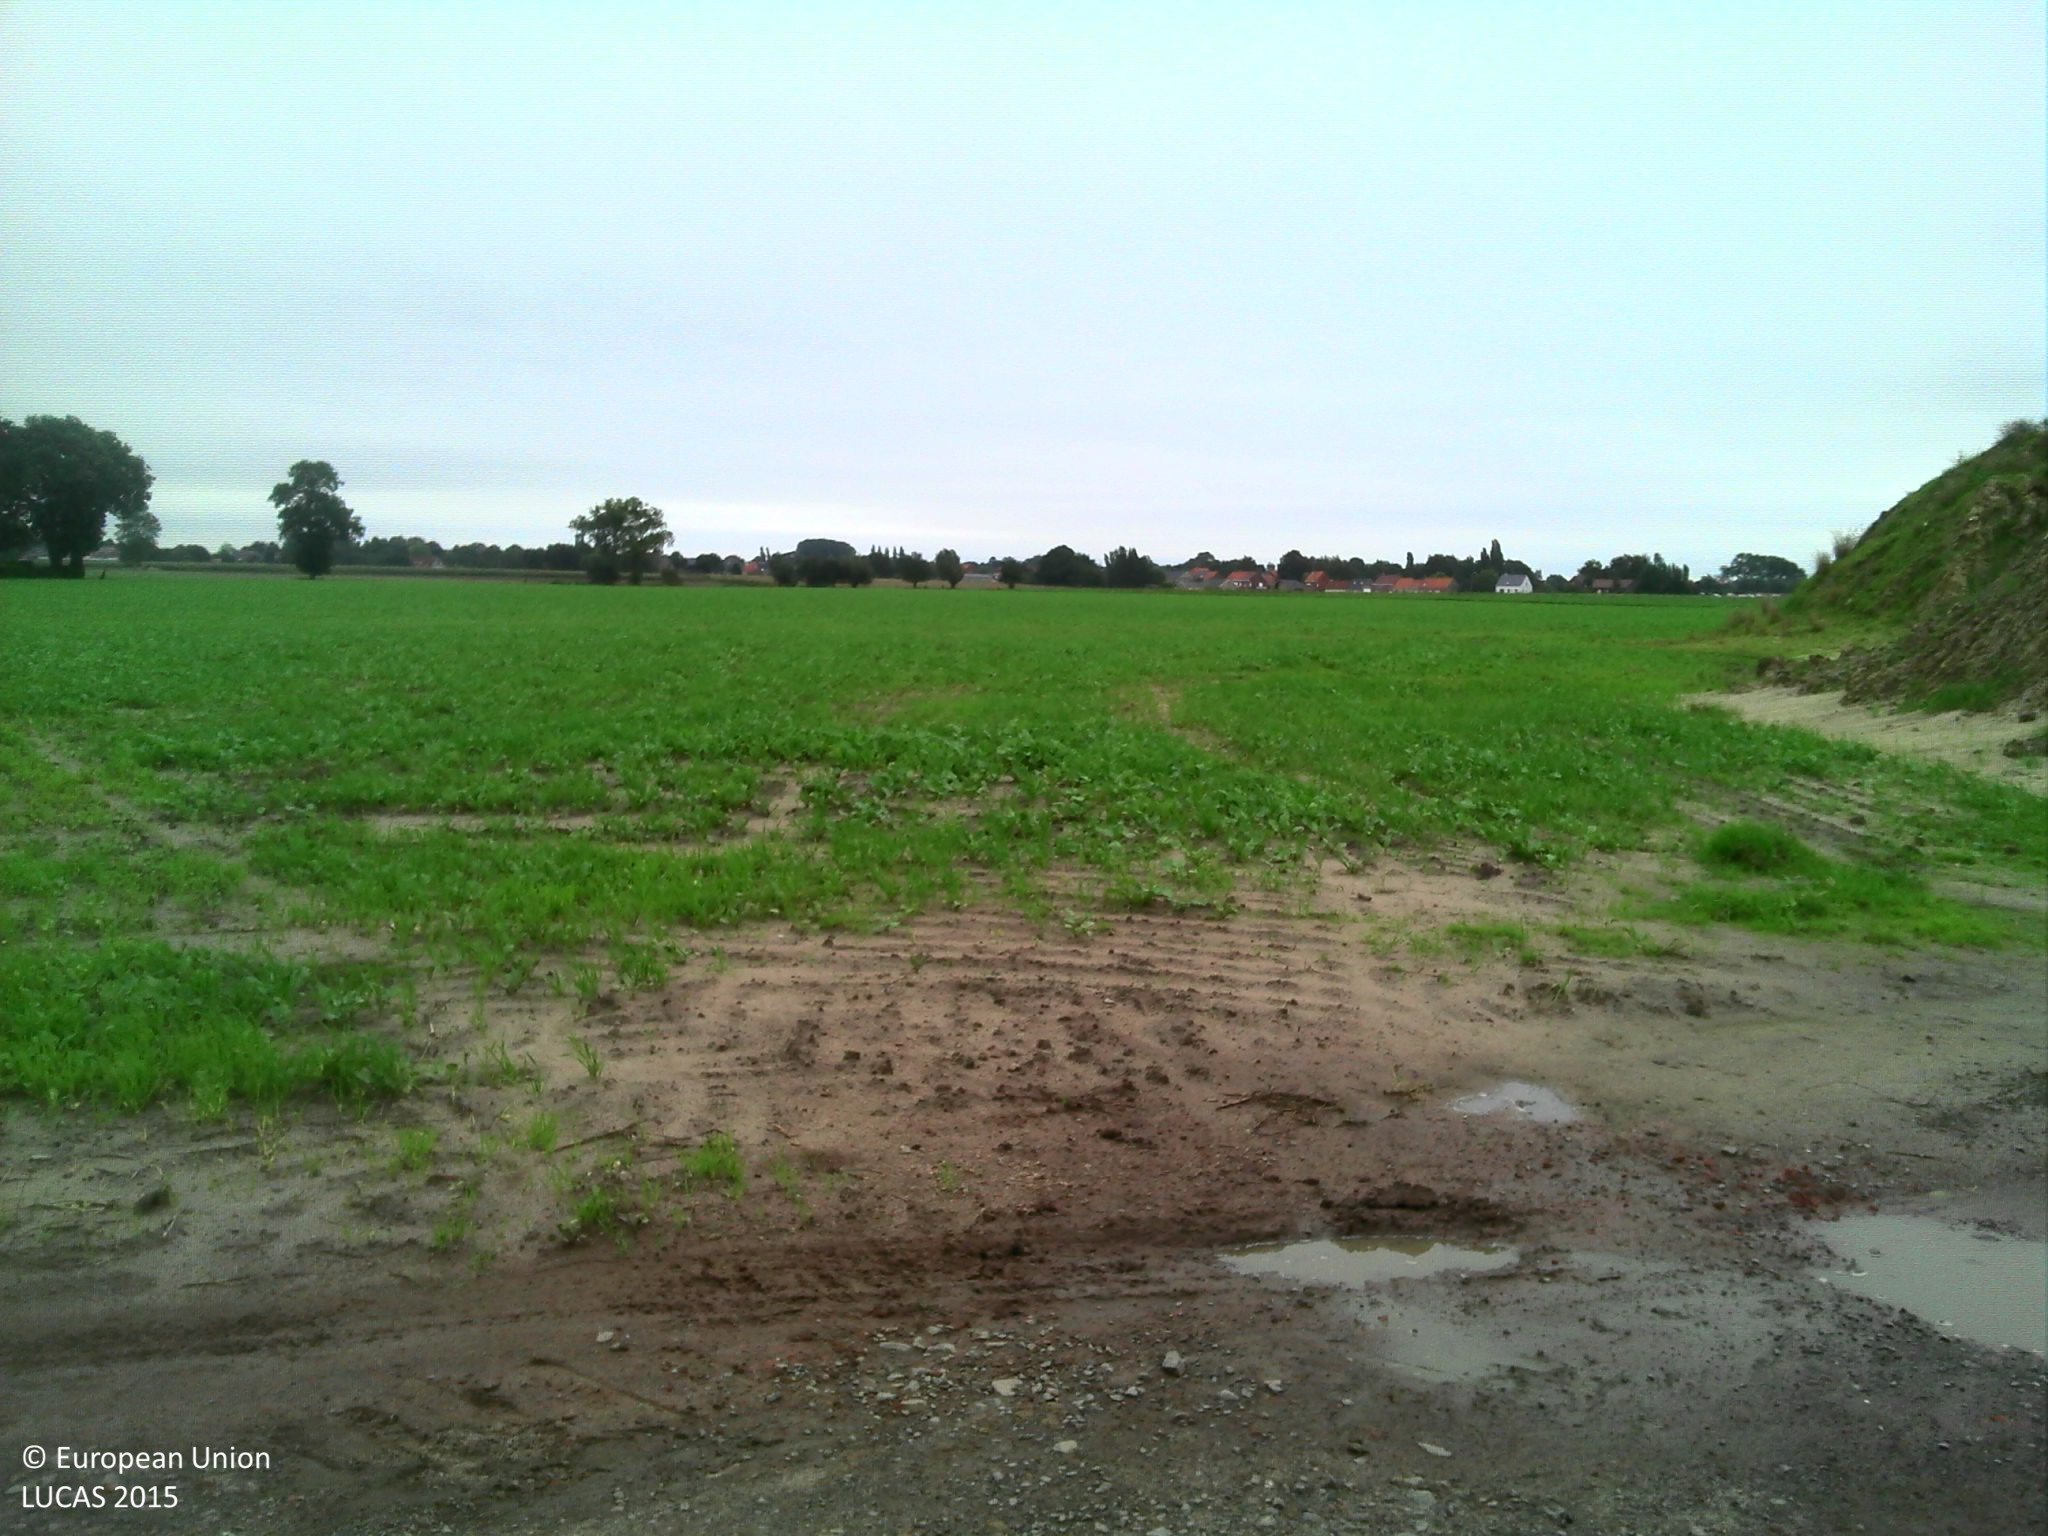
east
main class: Cropland
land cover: Maize
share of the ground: > 75 %
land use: Agriculture (excluding fallow land and kitchen gardens)
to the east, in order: Maize; Grass margins; Tracks; Grass margins; Spontaneously vegetated surfaces; Artificial constructions in urban areas; Spontaneously vegetated surfaces; Other root crops
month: September
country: BE
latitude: 51.0851
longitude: 2.9516
